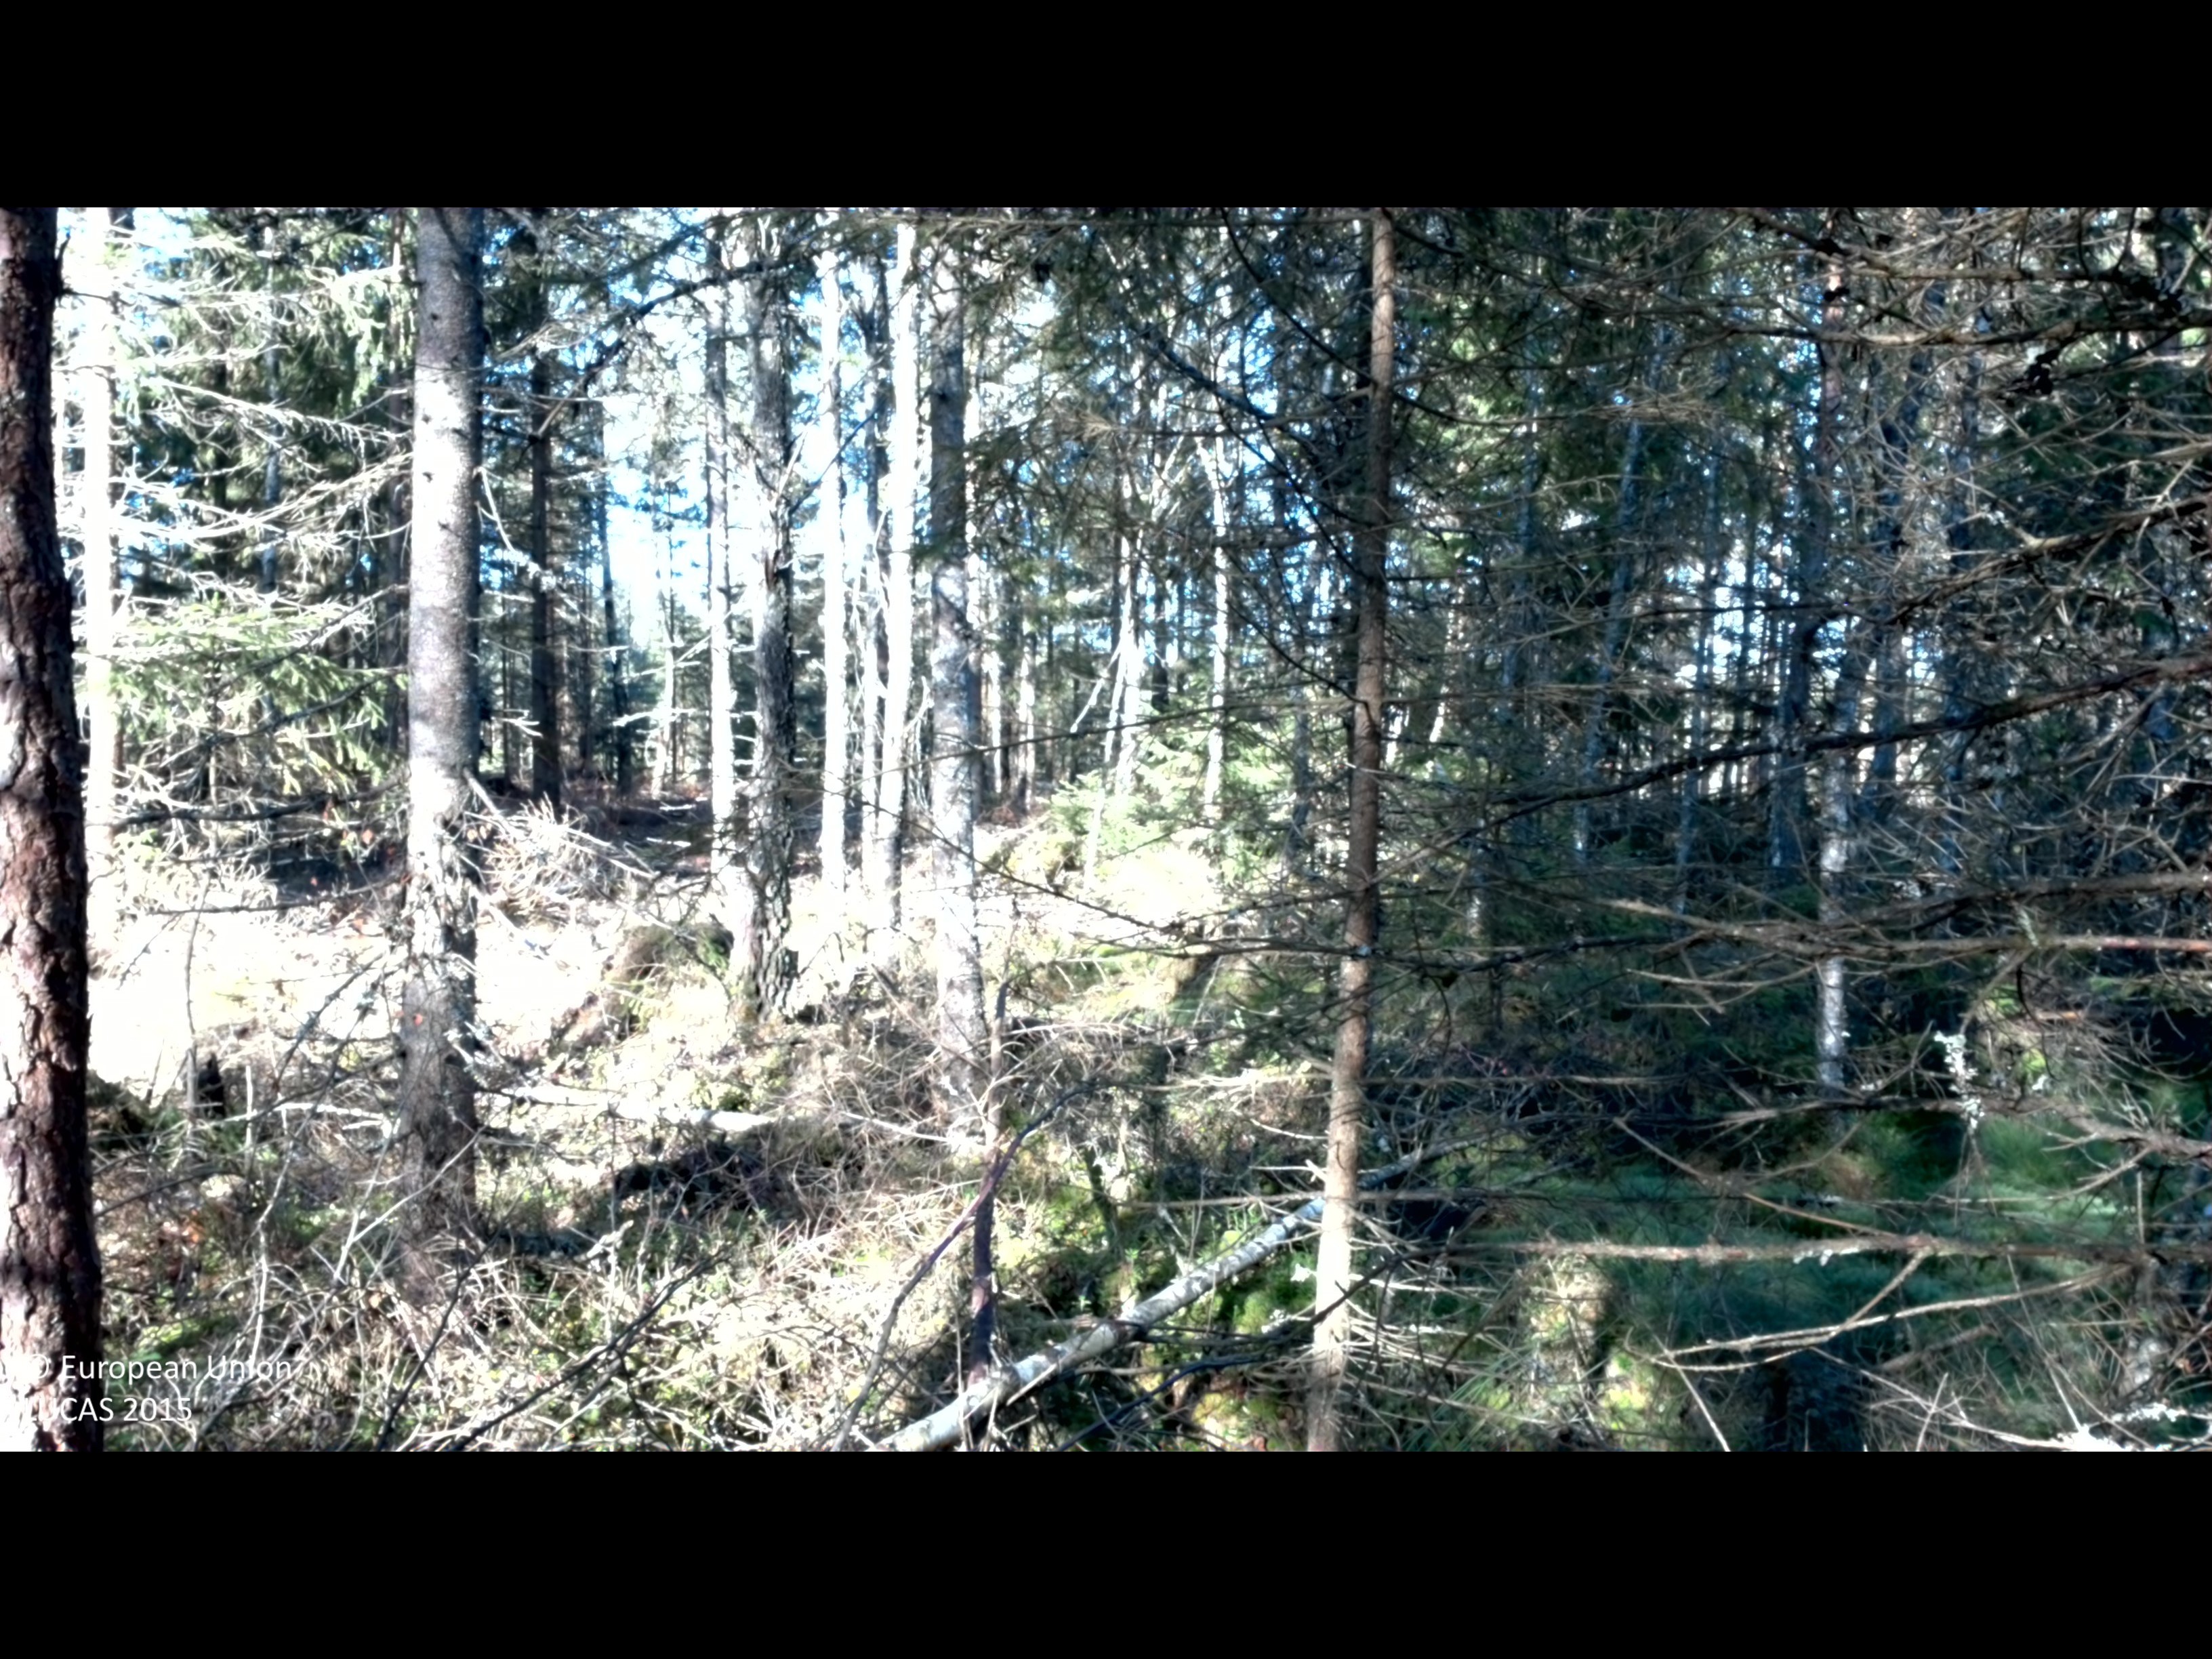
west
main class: Woodland
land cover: Spruce dominated mixed woodland
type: boreal forest
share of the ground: 50 - 75 %
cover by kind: coniferous forest trees 45 %, broadleaved forest trees 30 %, shrubs 10 %, lichens and mosses 10 %, herbaceous plants 5 %
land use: Forestry
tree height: > 5 m
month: September
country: SE
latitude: 57.0832
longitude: 13.2137
